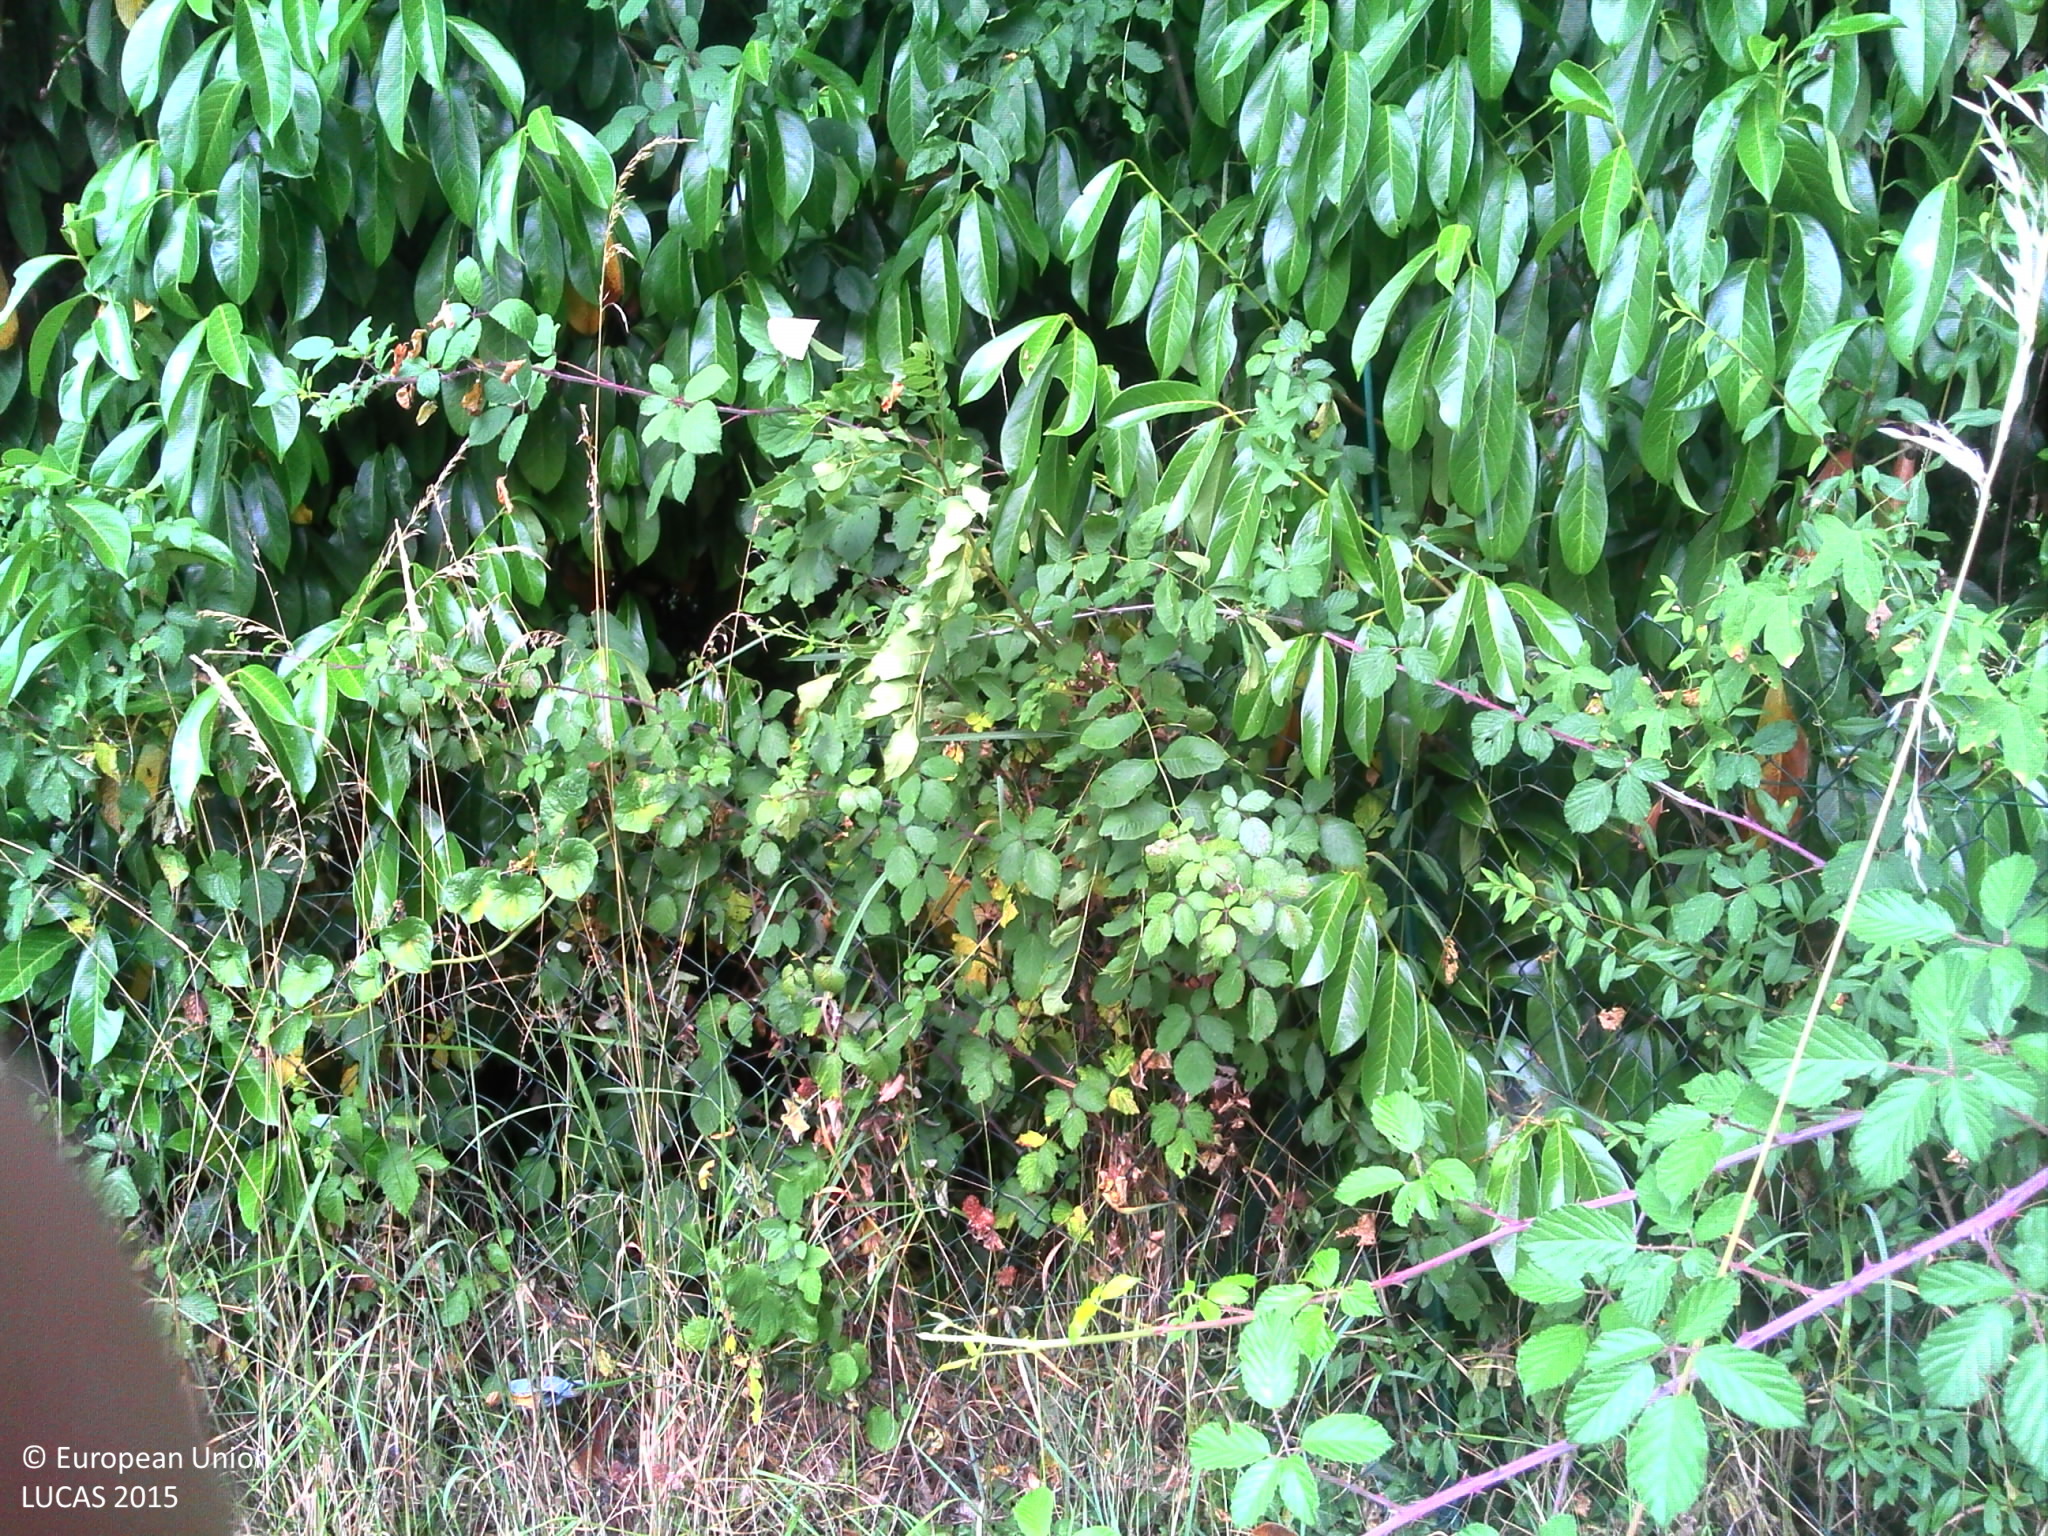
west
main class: Grassland
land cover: Grassland without tree/shrub cover
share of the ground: > 75 %
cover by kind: herbaceous plants 100 %
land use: Residential
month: July
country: FR
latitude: 46.1776
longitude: 6.2598
